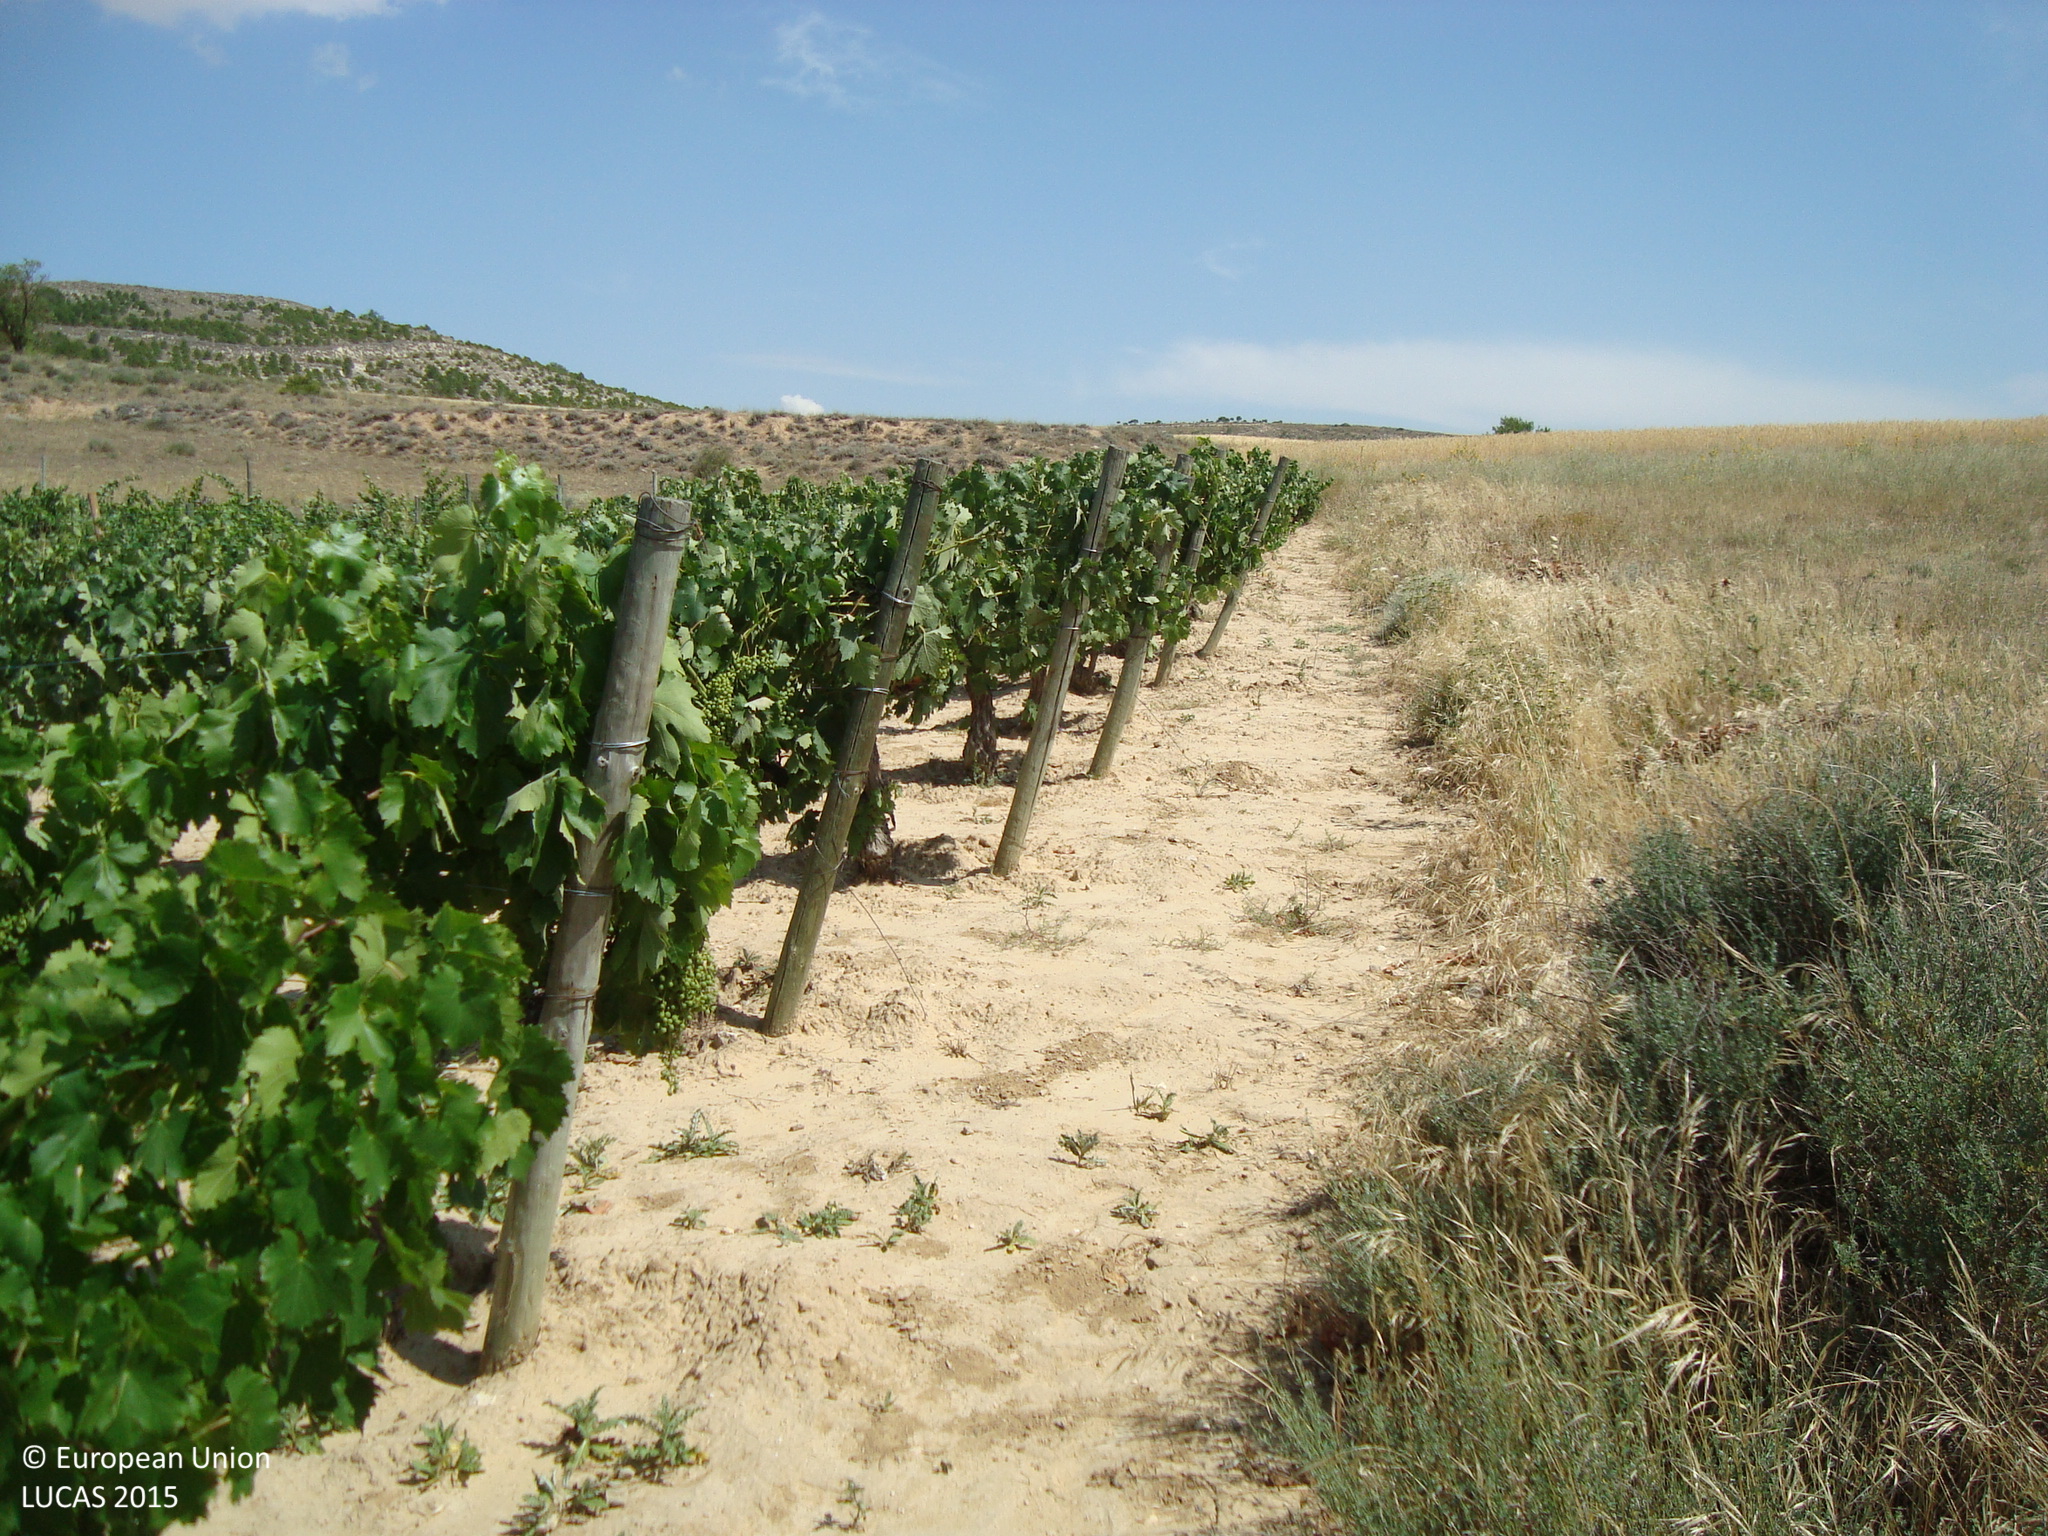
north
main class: Grassland
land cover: Grassland with sparse tree/shrub cover
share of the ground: > 75 %
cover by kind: herbaceous plants 50 %, unconsolidated bare surface 35 %, shrubs 10 %, broadleaved forest trees 5 %
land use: Abandoned areas
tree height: < 5 m
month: July
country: ES
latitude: 41.9534
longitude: -4.2398
